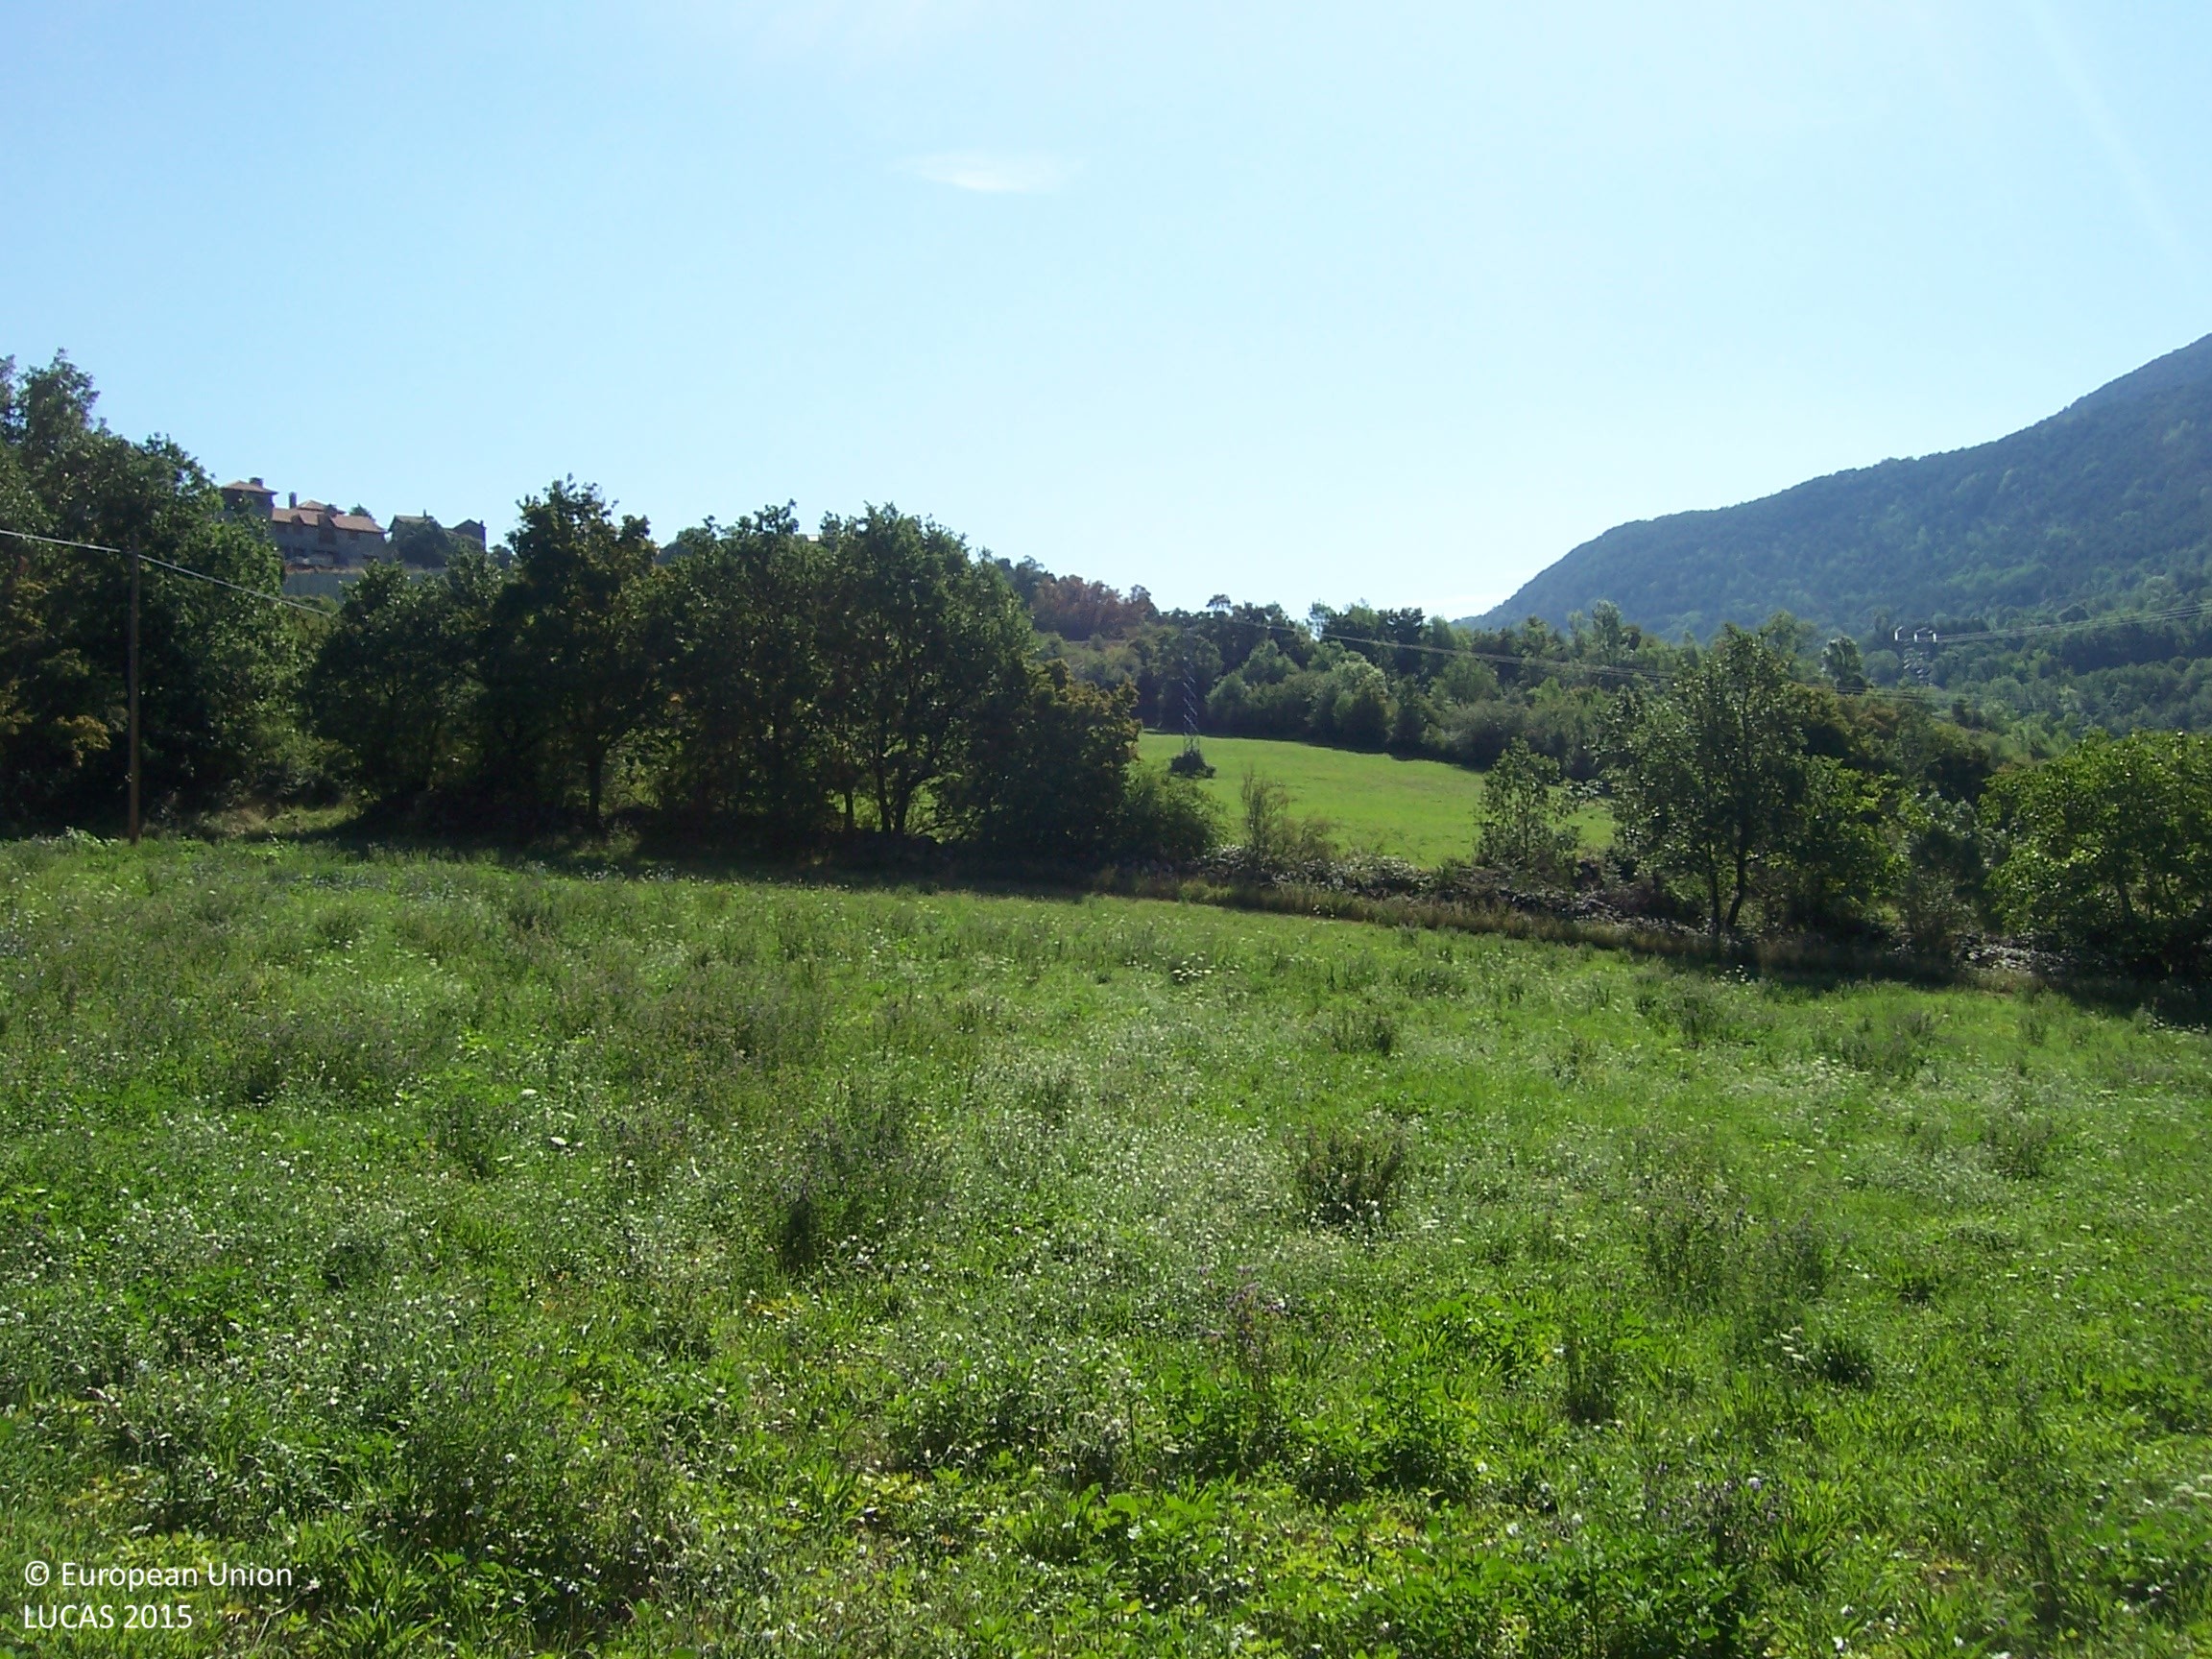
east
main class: Grassland
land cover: Grassland without tree/shrub cover
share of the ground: > 75 %
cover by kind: herbaceous plants 100 %
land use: Agriculture (excluding fallow land and kitchen gardens)
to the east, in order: Grassland without tree/shrub cover; Dry stone walls; Groves; Fences; Grassland without tree/shrub cover; Electric lines; Grassland without tree/shrub cover; Broadleaved woodland
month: August
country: ES
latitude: 42.6184
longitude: -0.3032
